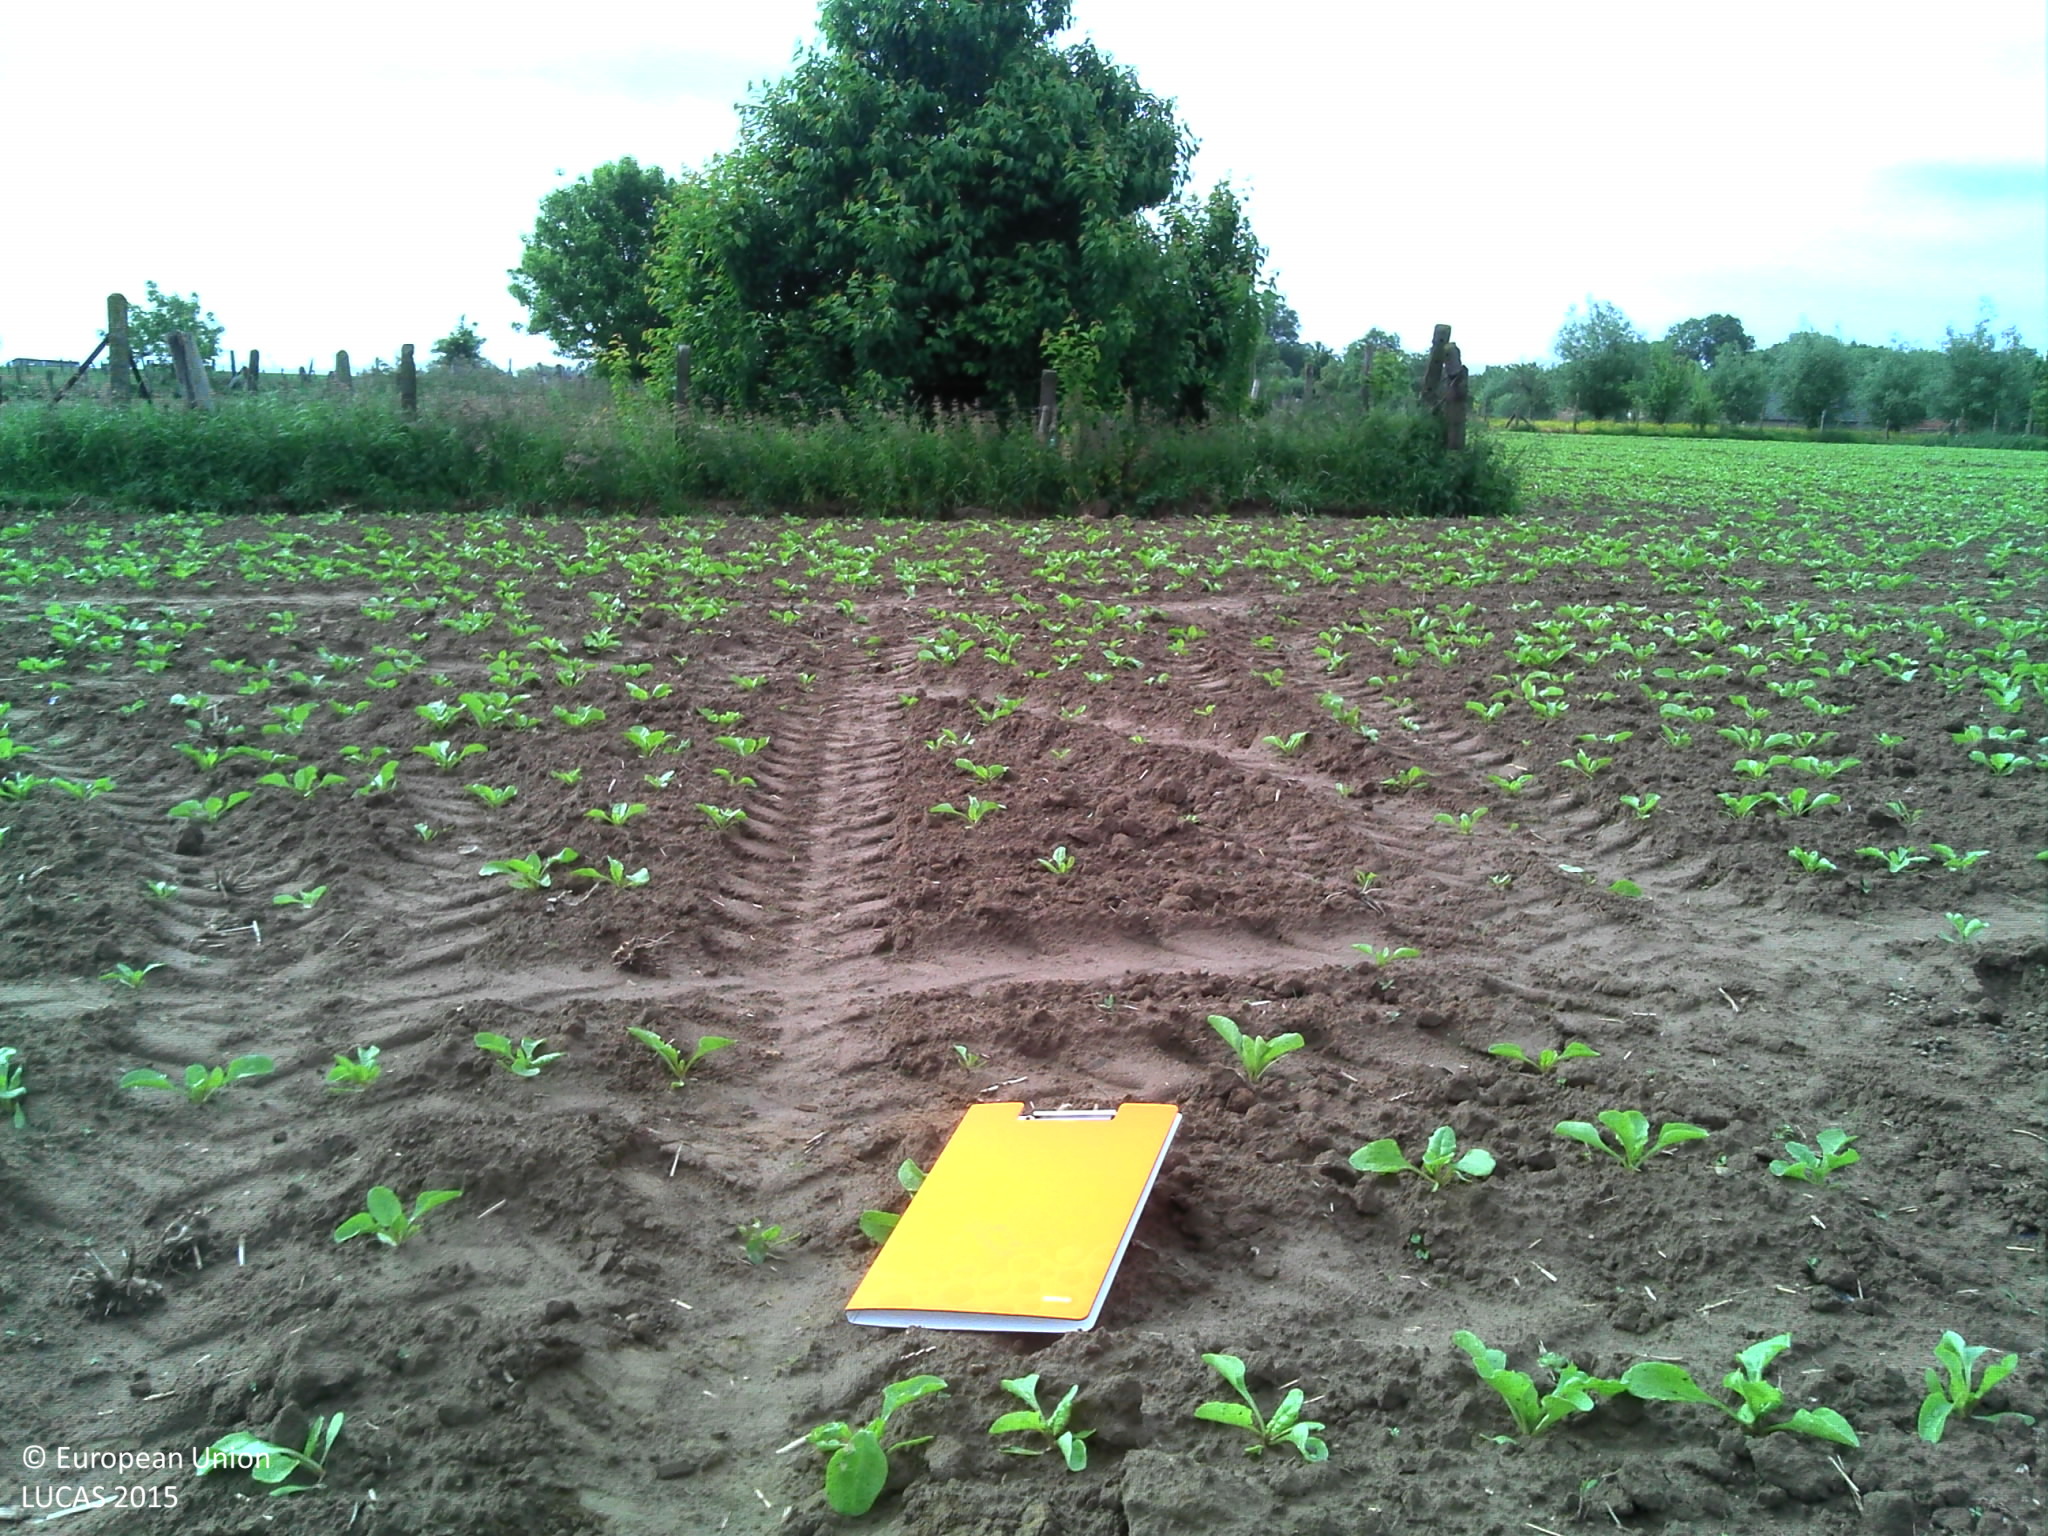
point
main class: Cropland
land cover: Sugar beet
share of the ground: 10 - 25 %
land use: Agriculture (excluding fallow land and kitchen gardens)
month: June
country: BE
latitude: 50.8264
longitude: 4.1314
